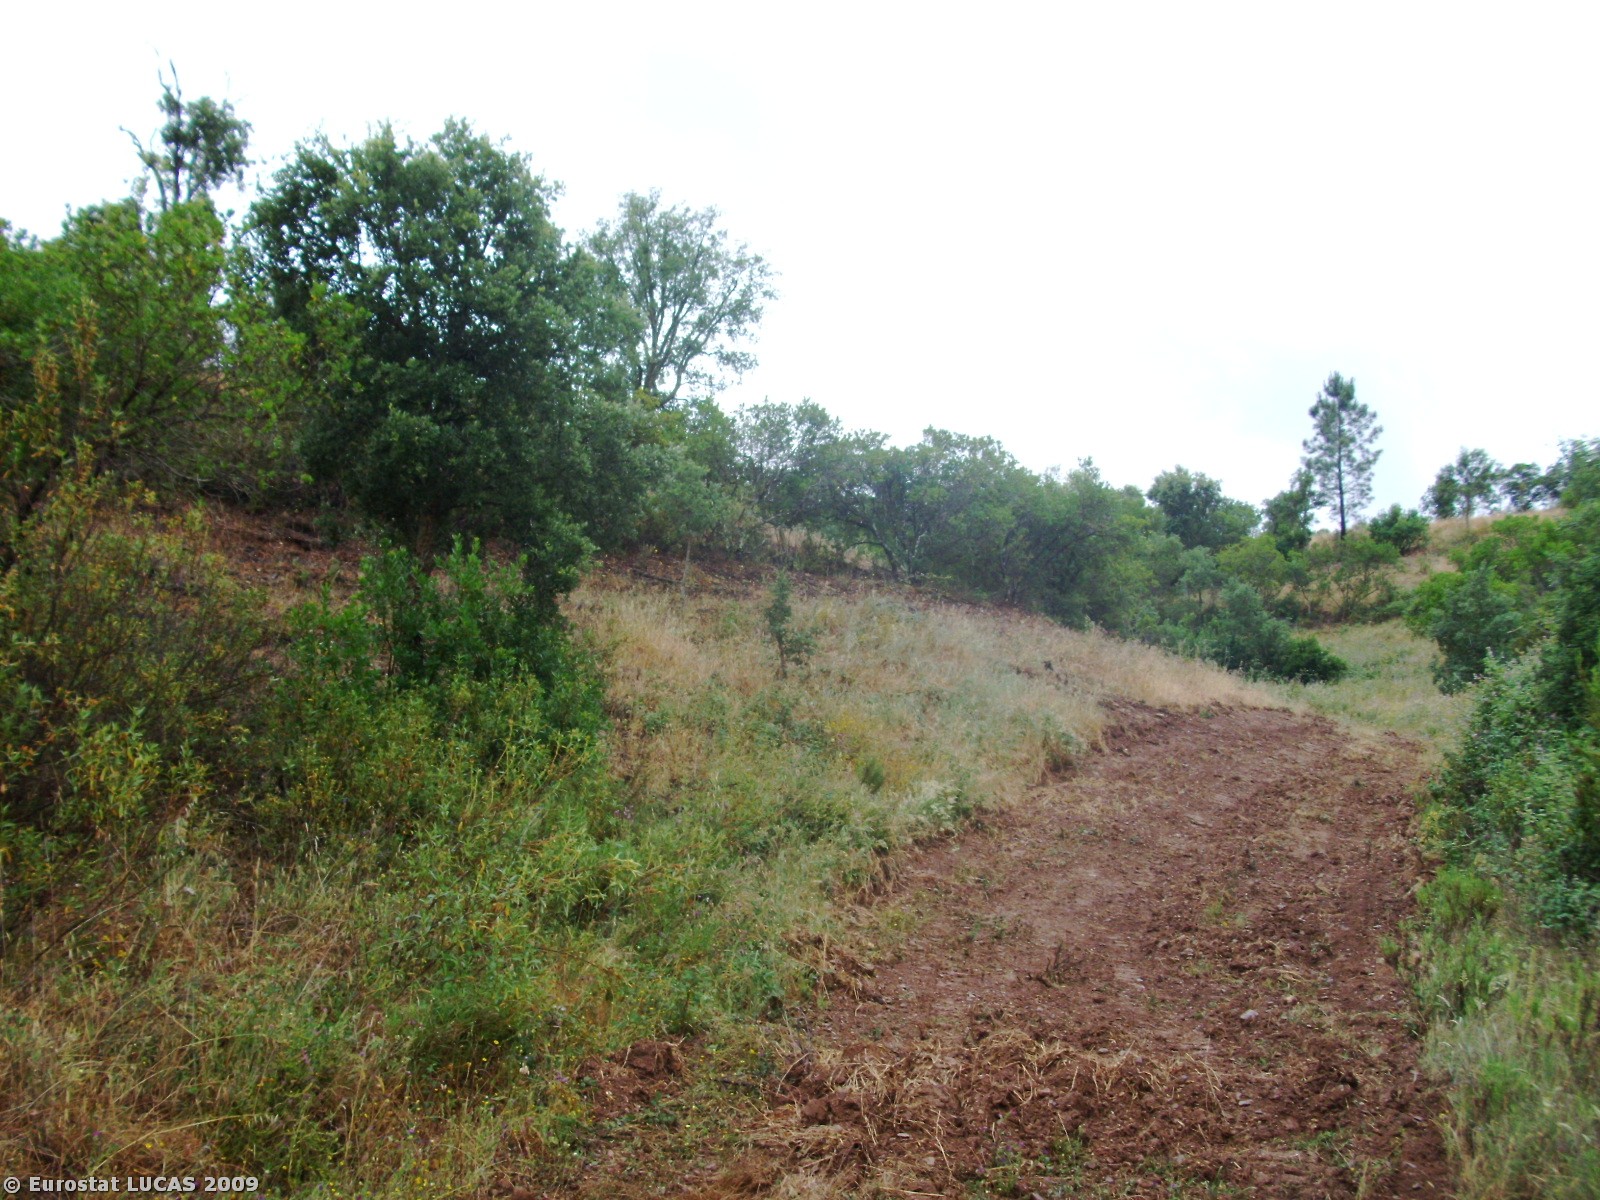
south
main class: Shrubland
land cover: Shrubland with sparse tree cover
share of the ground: > 75 %
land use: Fallow land
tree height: > 5 m
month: June
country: PT
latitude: 37.3892
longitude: -8.4507
